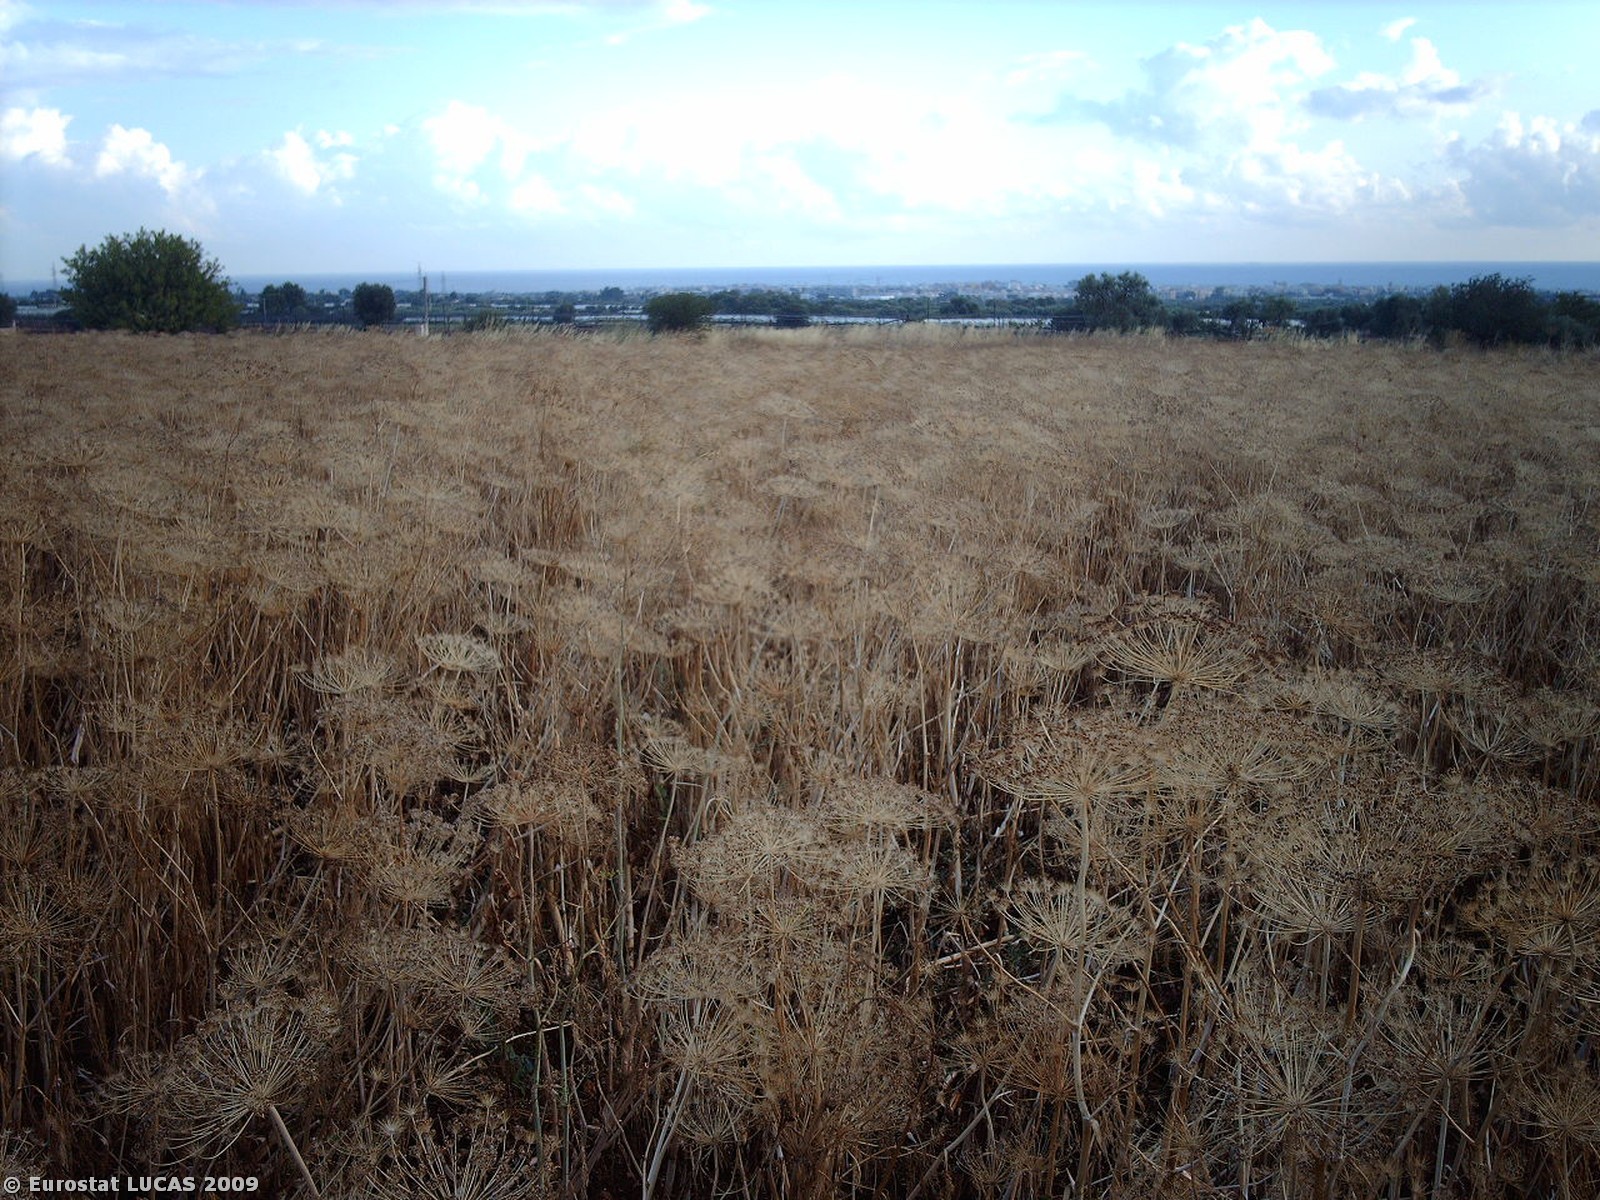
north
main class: Grassland
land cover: Spontaneously vegetated surfaces
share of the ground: > 75 %
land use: Fallow land
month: August
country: IT
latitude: 41.0279
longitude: 17.0794
